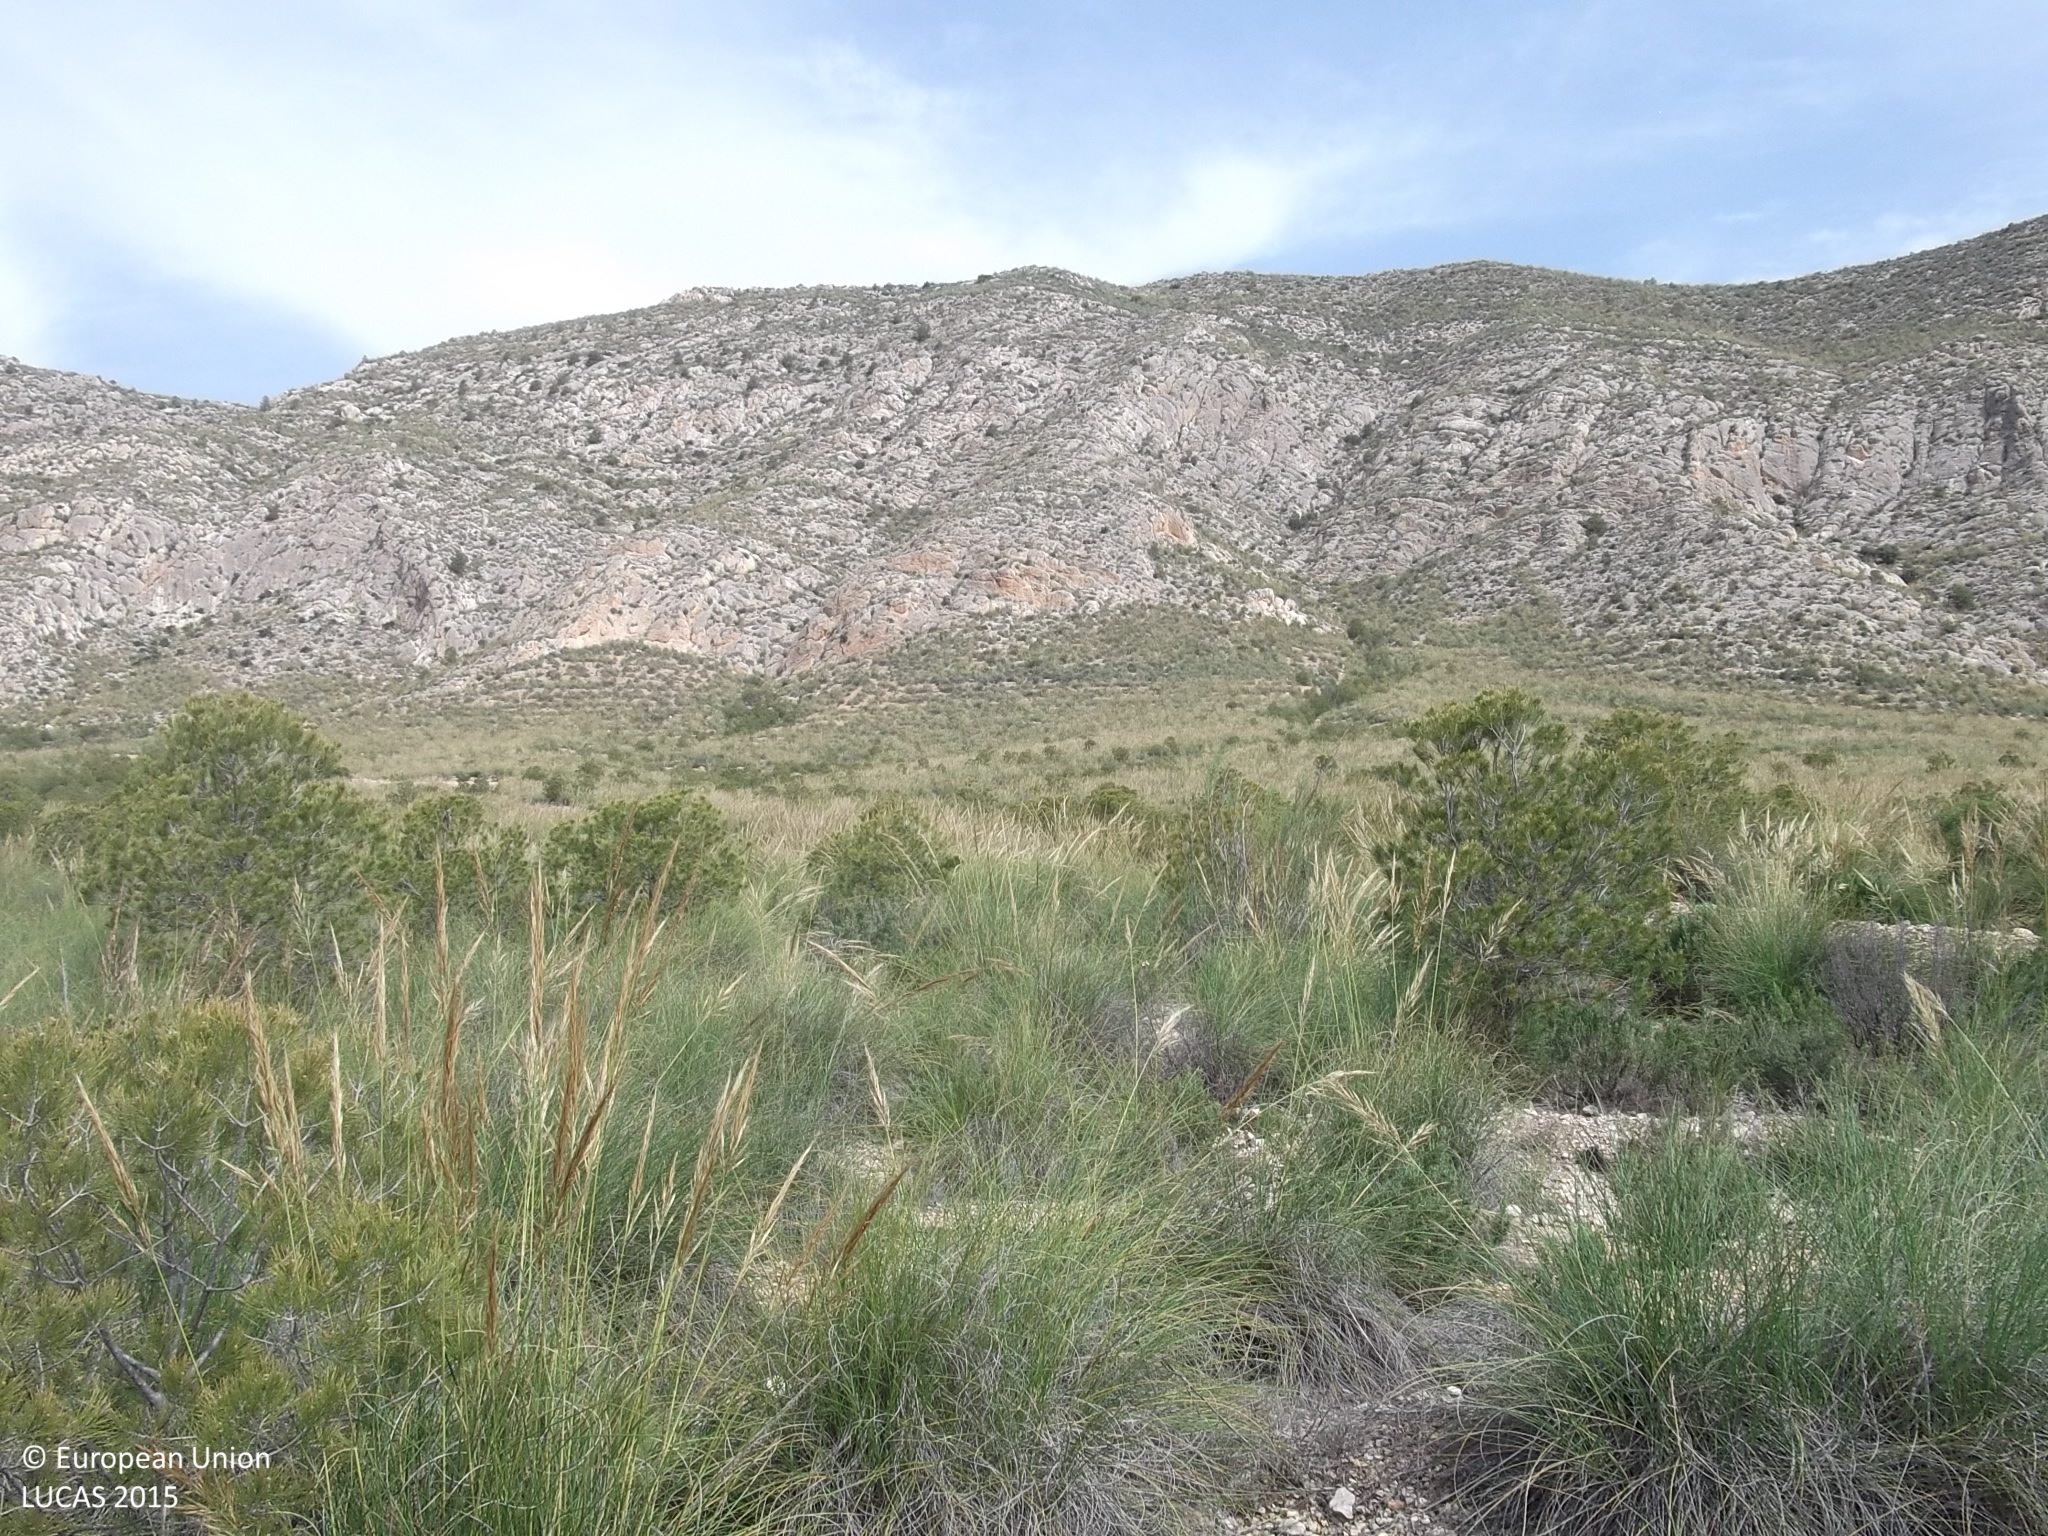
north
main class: Woodland
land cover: Pine dominated coniferous woodland
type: coniferous forest of the mediterranean region
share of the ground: 10 - 25 %
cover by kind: shrubs 65 %, consolidated bare surface 20 %, coniferous forest trees 15 %
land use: Semi-natural and natural areas not in use
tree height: < 5 m
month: April
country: ES
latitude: 38.2953
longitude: -1.6186
